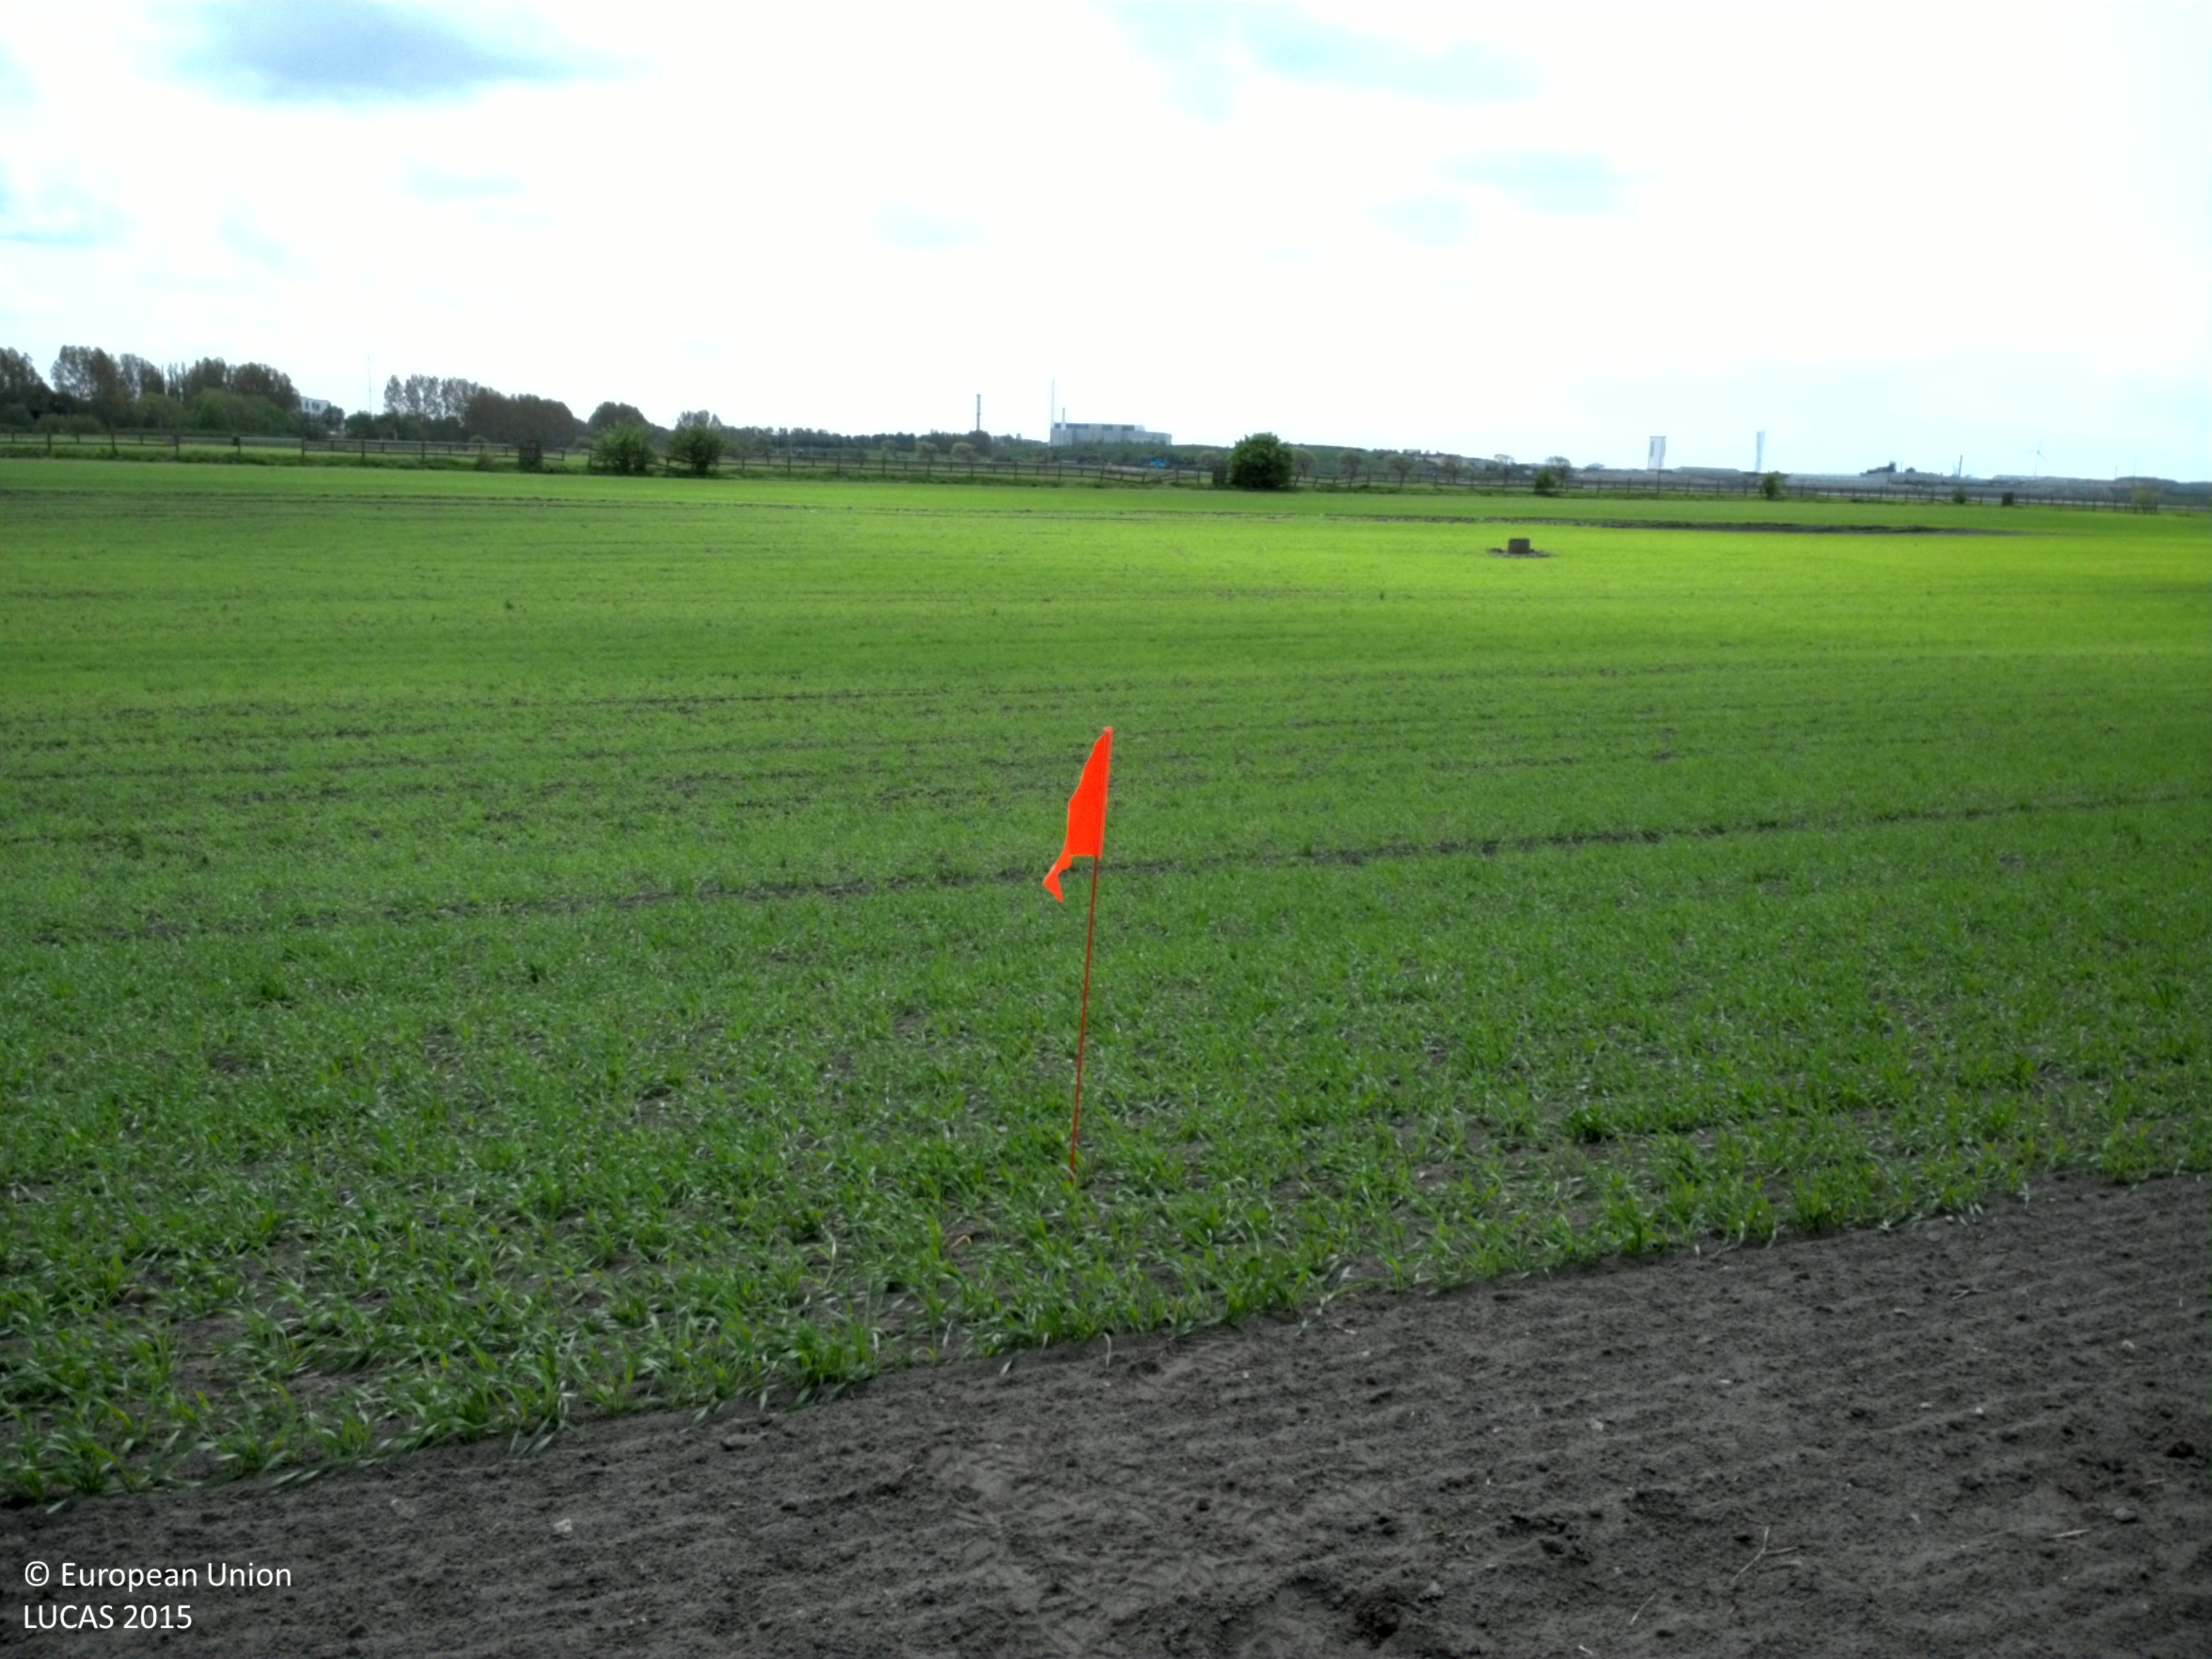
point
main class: Cropland
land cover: Barley
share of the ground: > 75 %
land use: Agriculture (excluding fallow land and kitchen gardens)
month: May
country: SE
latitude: 55.6475
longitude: 13.0648
